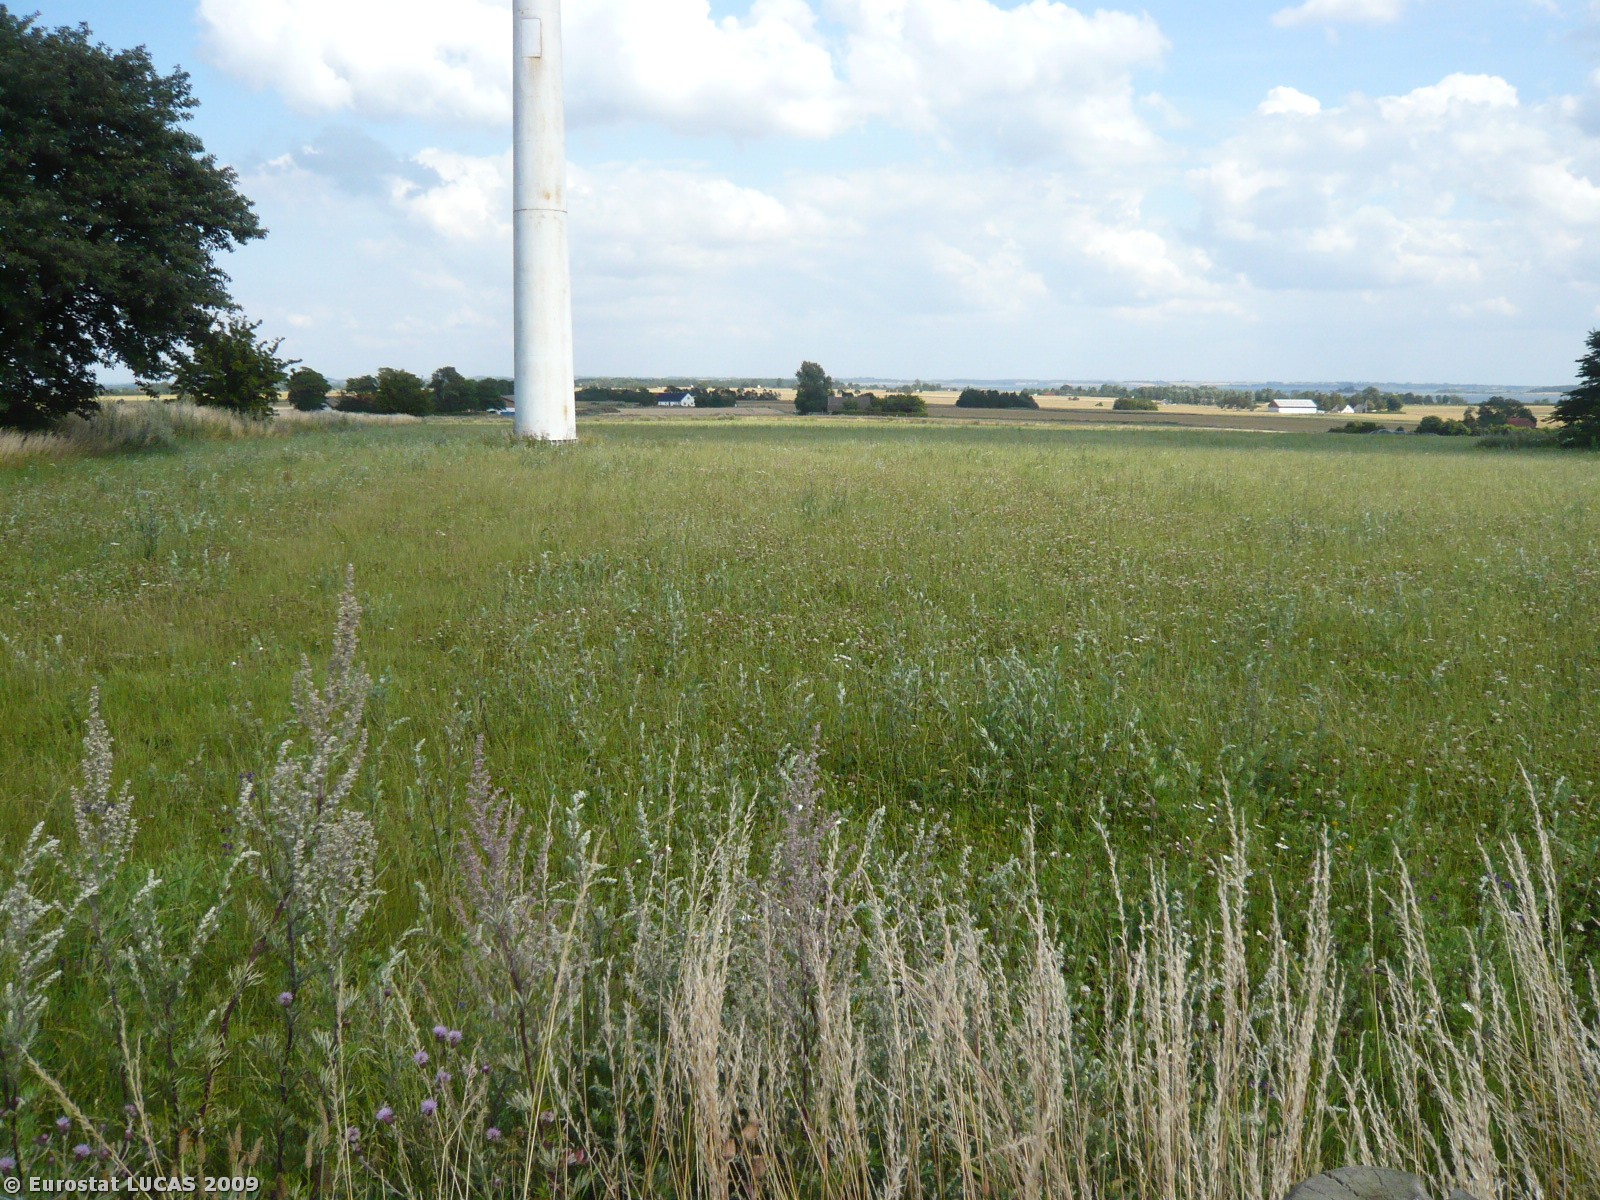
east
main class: Grassland
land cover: Grassland without tree/shrub cover
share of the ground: > 75 %
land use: Agriculture (excluding fallow land and kitchen gardens)
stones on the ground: < 10 %
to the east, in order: Grassland without tree/shrub cover; Fences; Barley
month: July
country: DK
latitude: 55.7450
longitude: 11.7029
